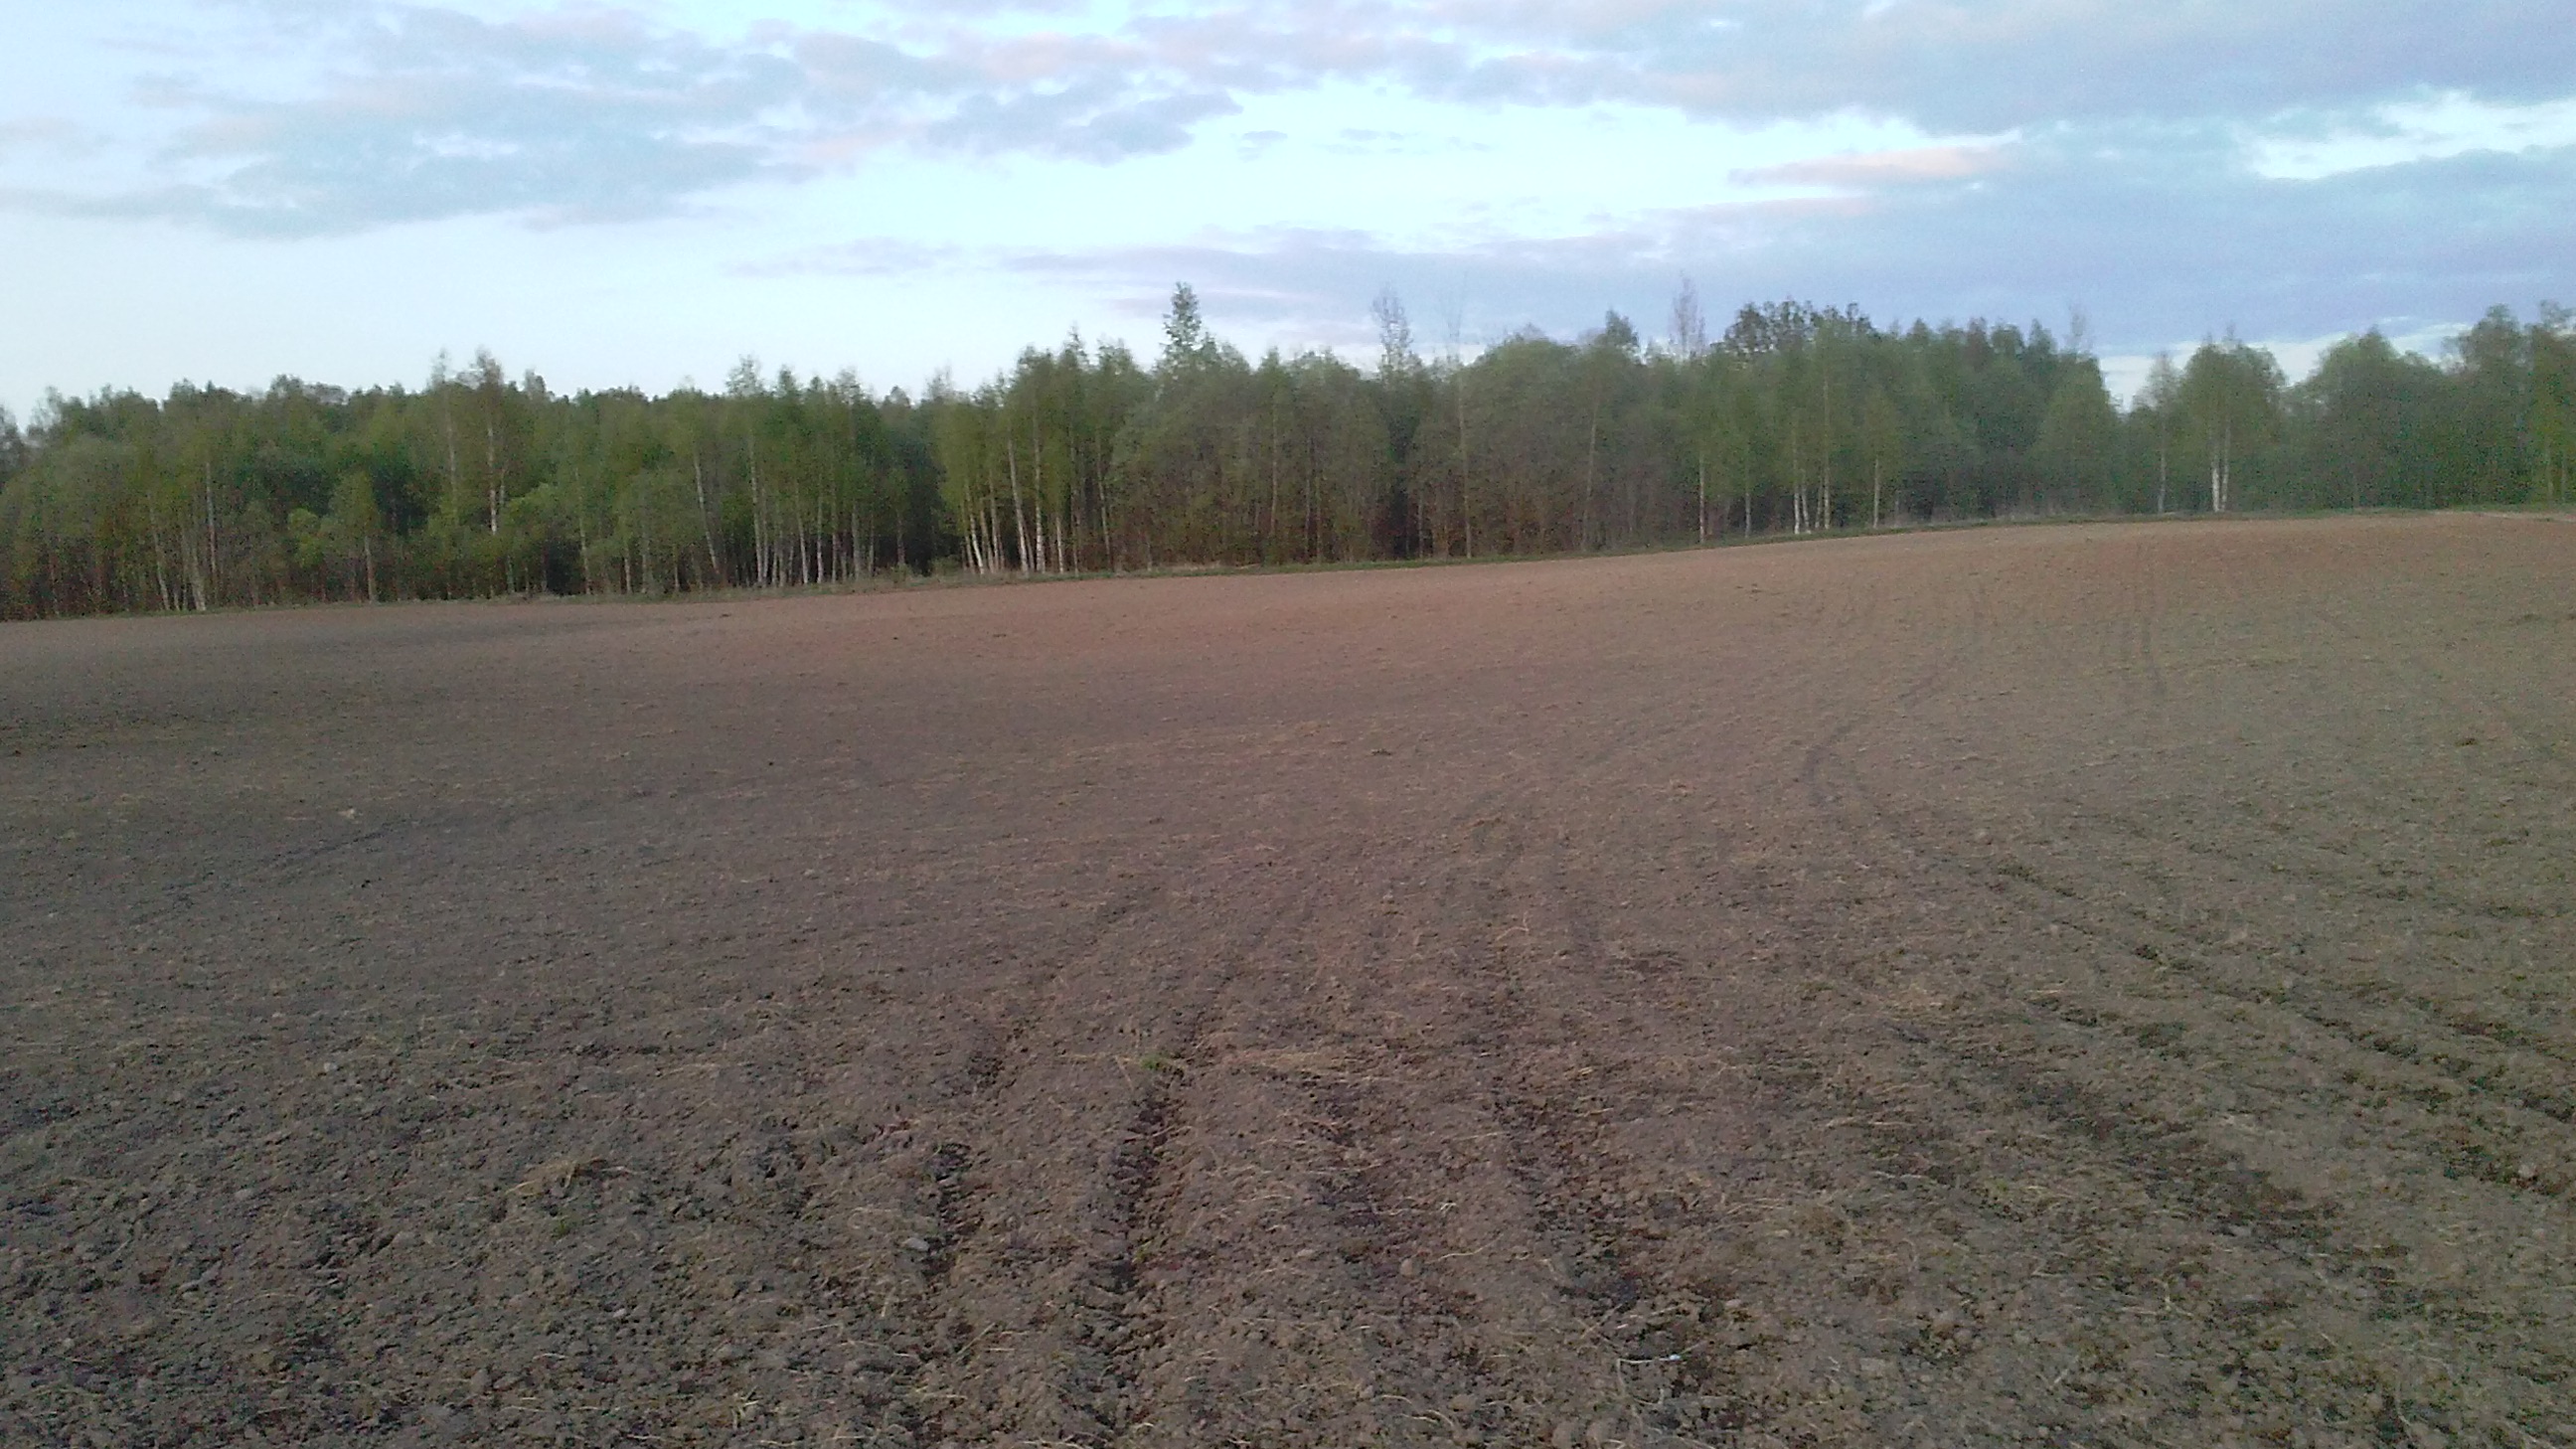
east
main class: Cropland
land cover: Oats
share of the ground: < 10 %
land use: Agriculture (excluding fallow land and kitchen gardens)
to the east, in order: Oats; Tracks; Broadleaved woodland
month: May
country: LV
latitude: 55.9366
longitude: 27.5860
